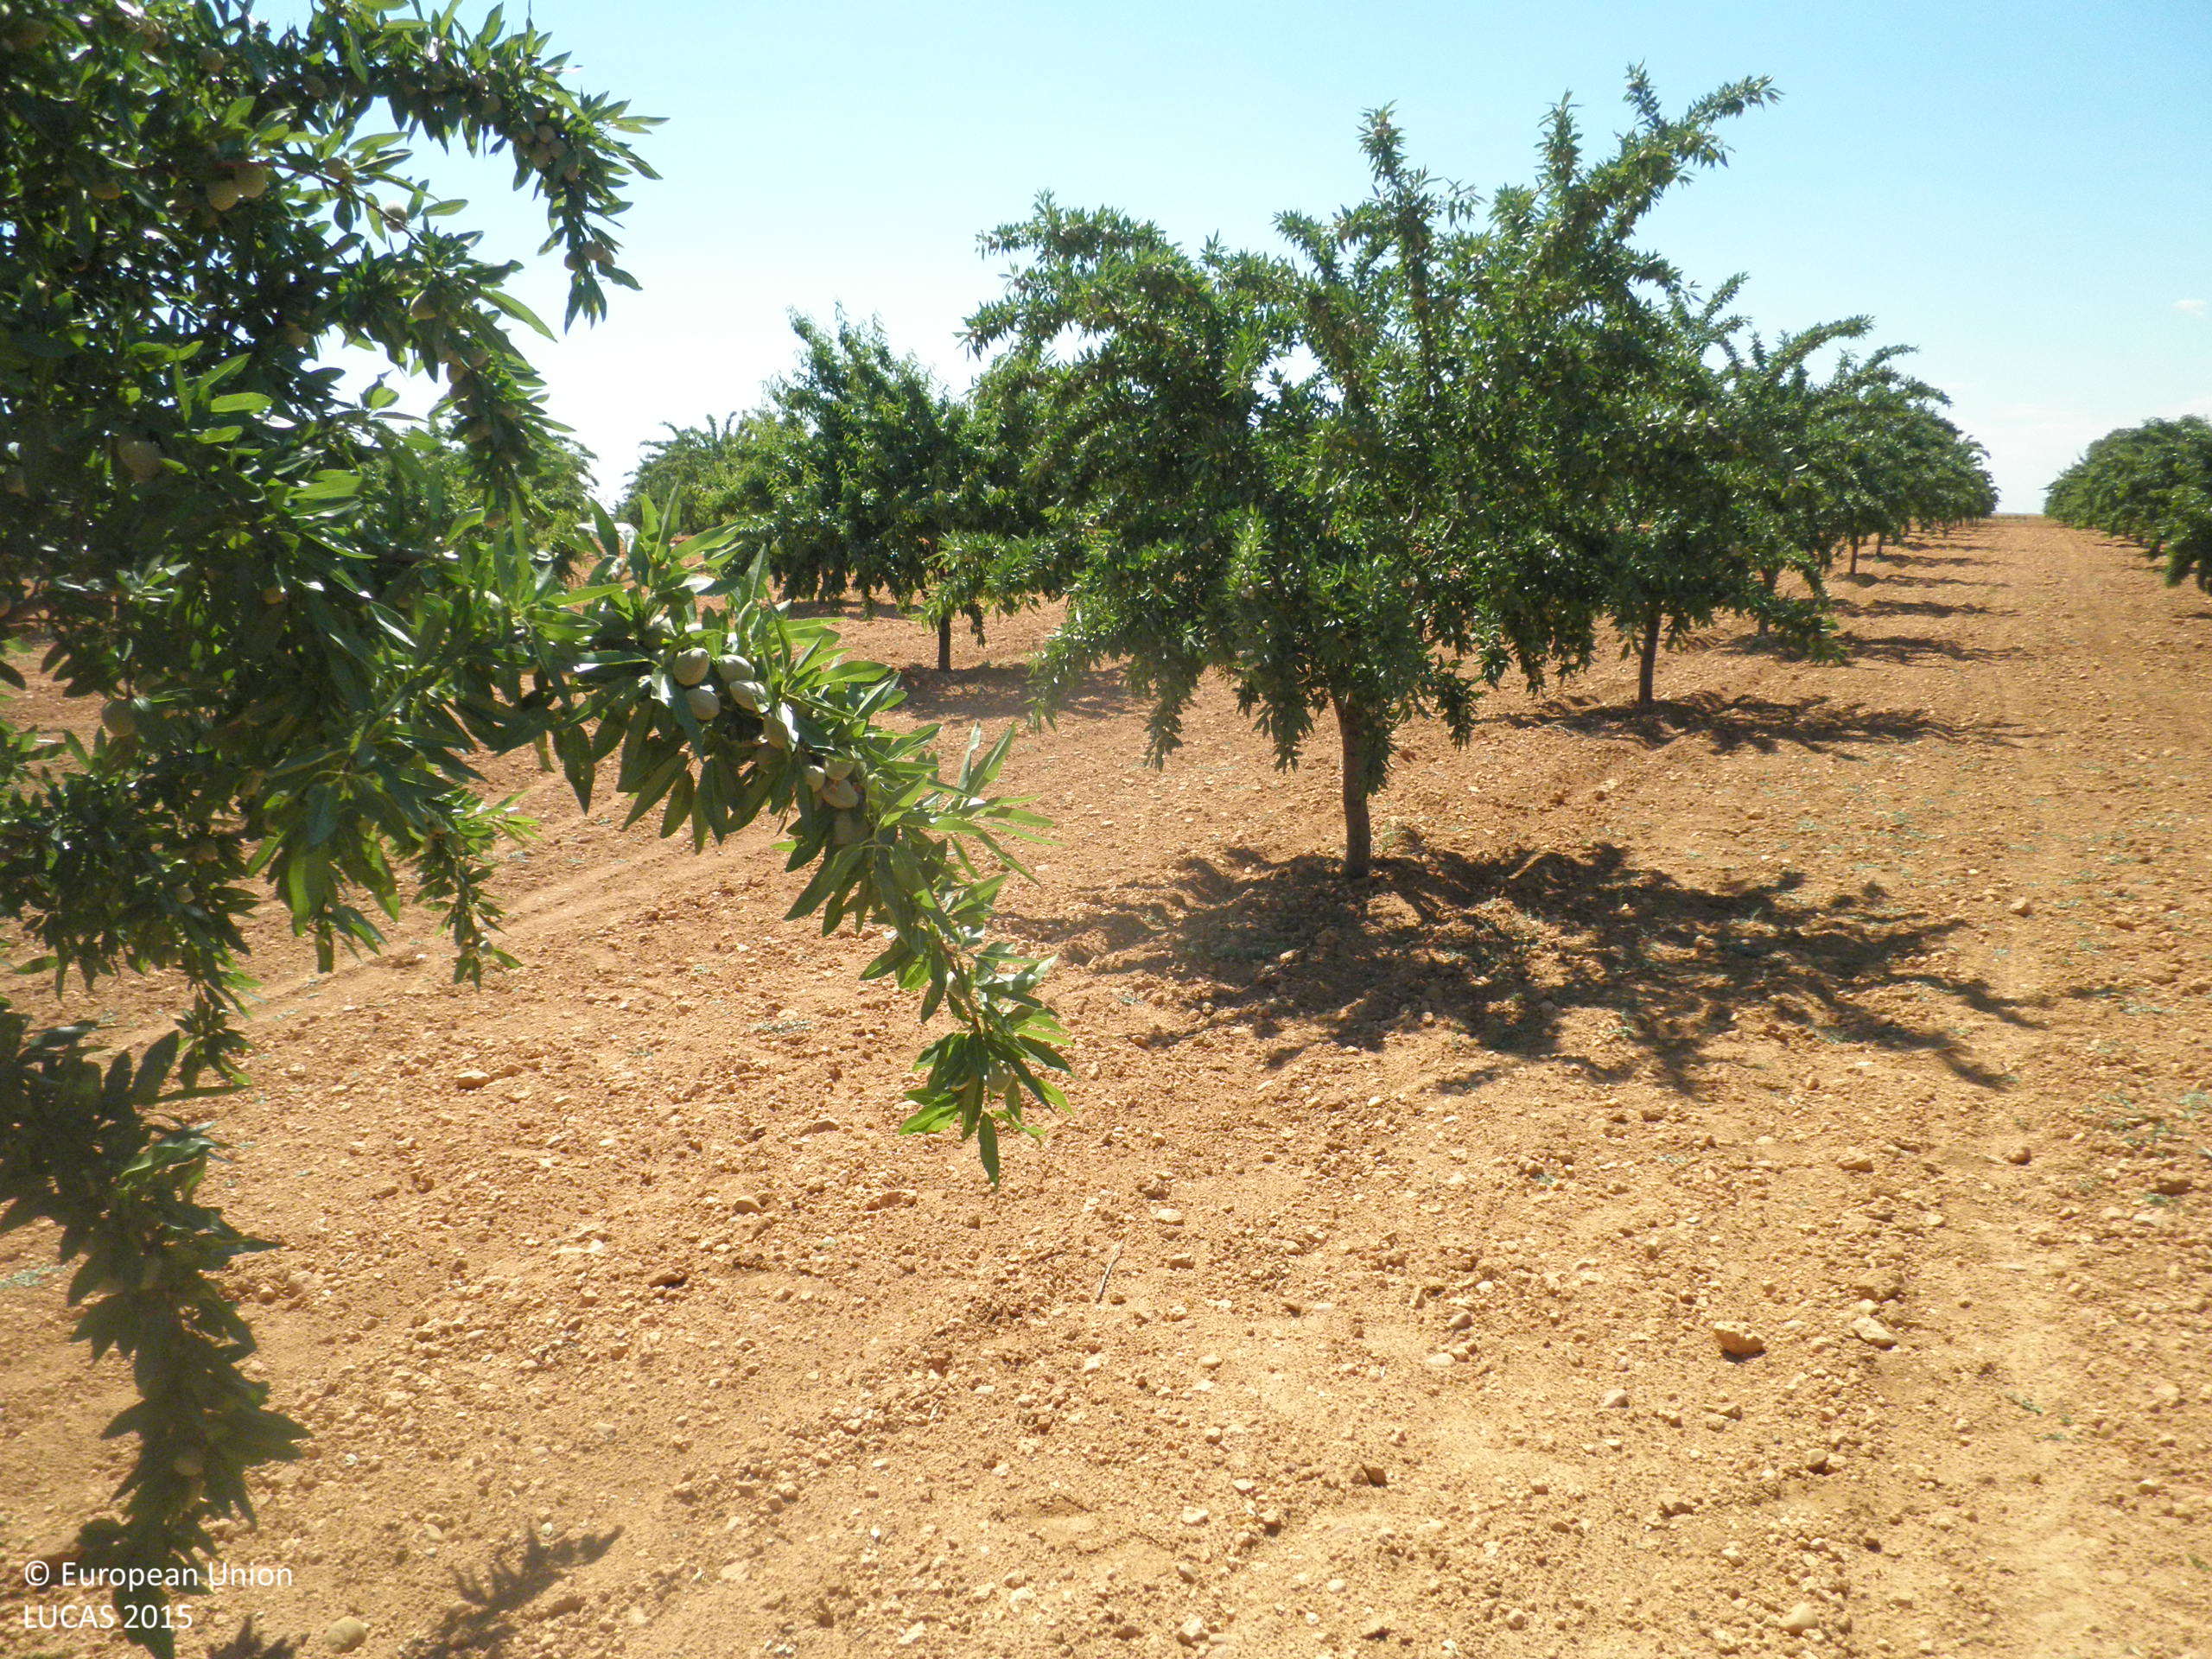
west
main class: Cropland
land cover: Nuts trees
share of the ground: 10 - 25 %
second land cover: Other bare soil
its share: > 75 %
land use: Agriculture (excluding fallow land and kitchen gardens)
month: June
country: ES
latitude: 39.3866
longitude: -1.8124
